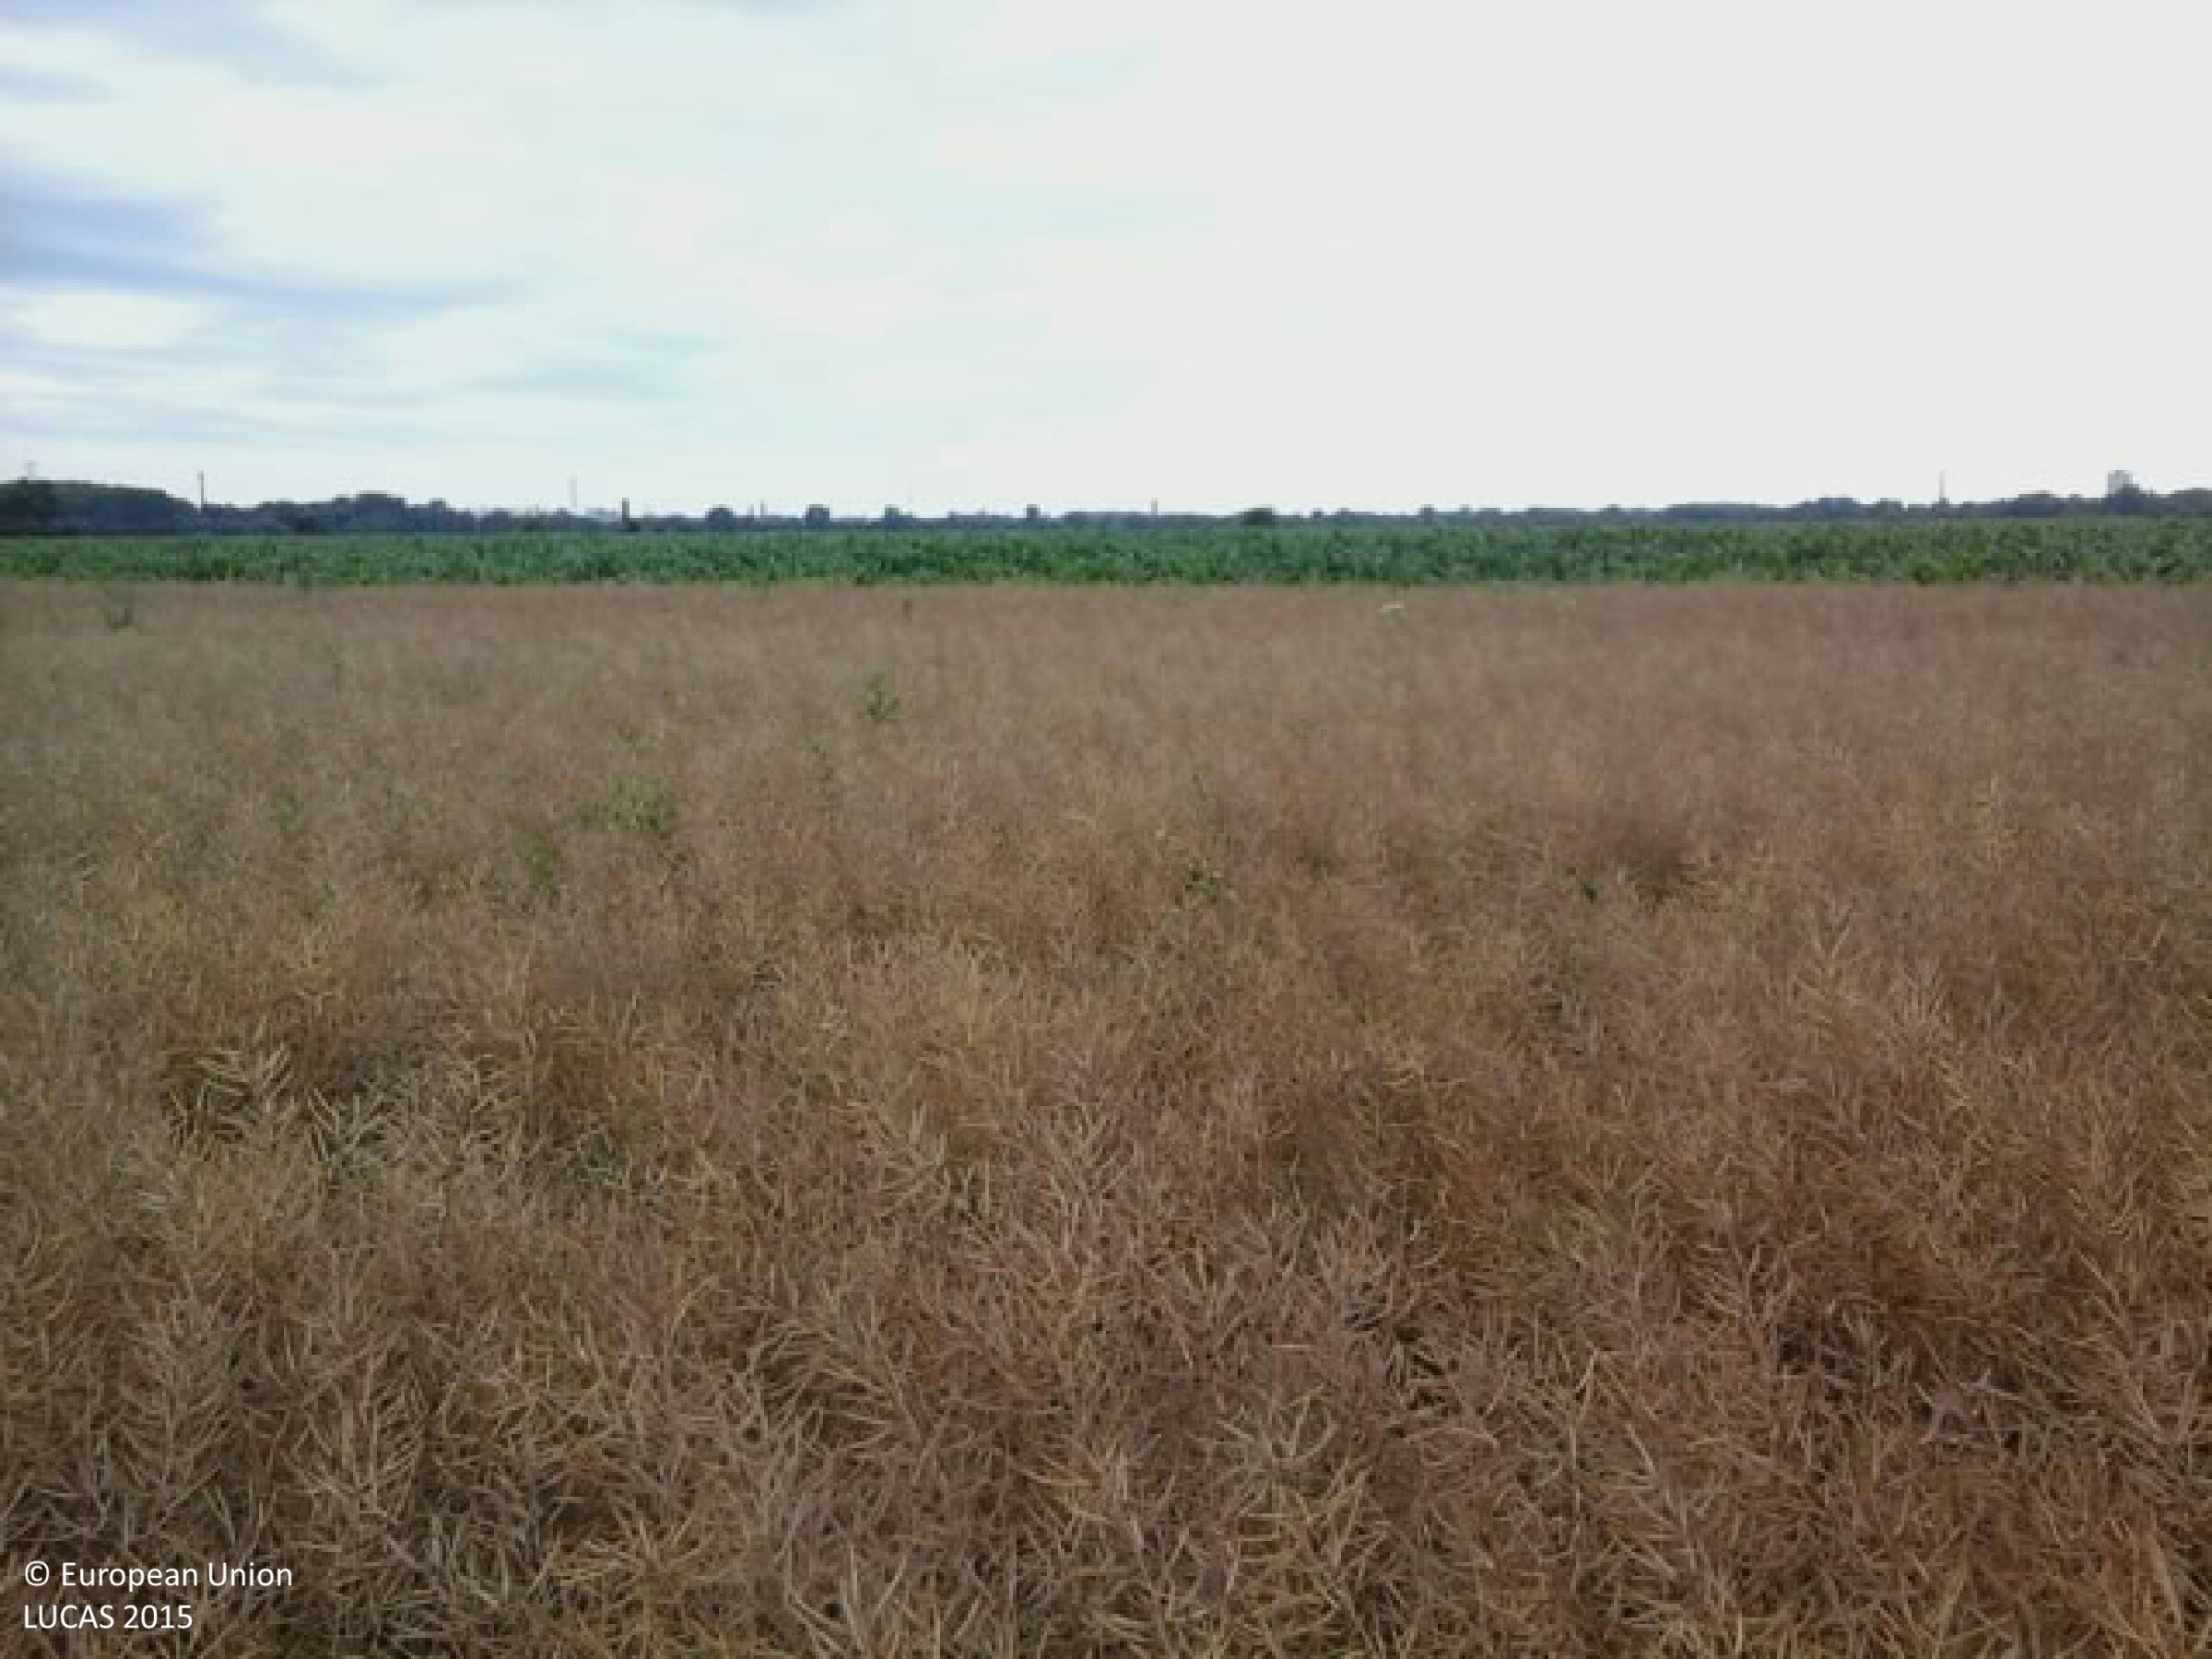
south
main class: Cropland
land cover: Rape and turnip rape
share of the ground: > 75 %
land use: Agriculture (excluding fallow land and kitchen gardens)
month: June
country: HU
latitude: 46.2115
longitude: 18.9428
